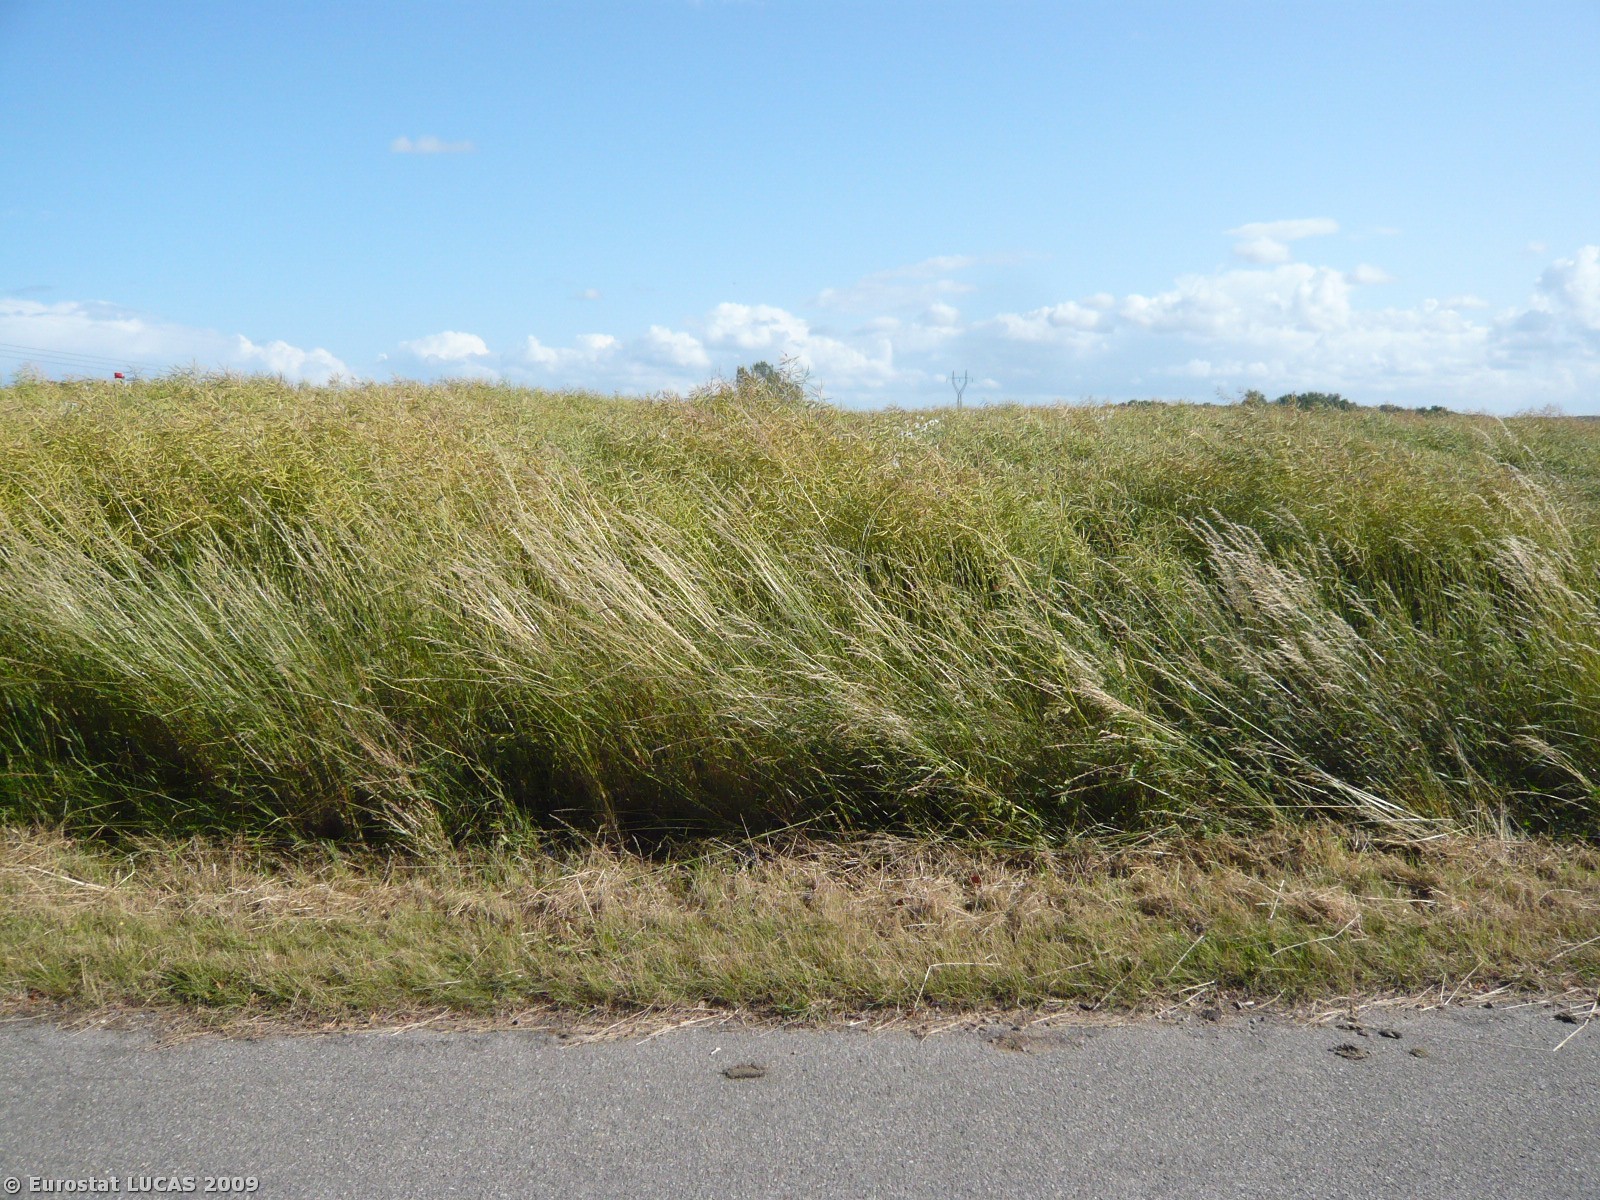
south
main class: Grassland
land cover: Grassland without tree/shrub cover
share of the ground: > 75 %
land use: Residential
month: July
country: DK
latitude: 55.3233
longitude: 10.6456
